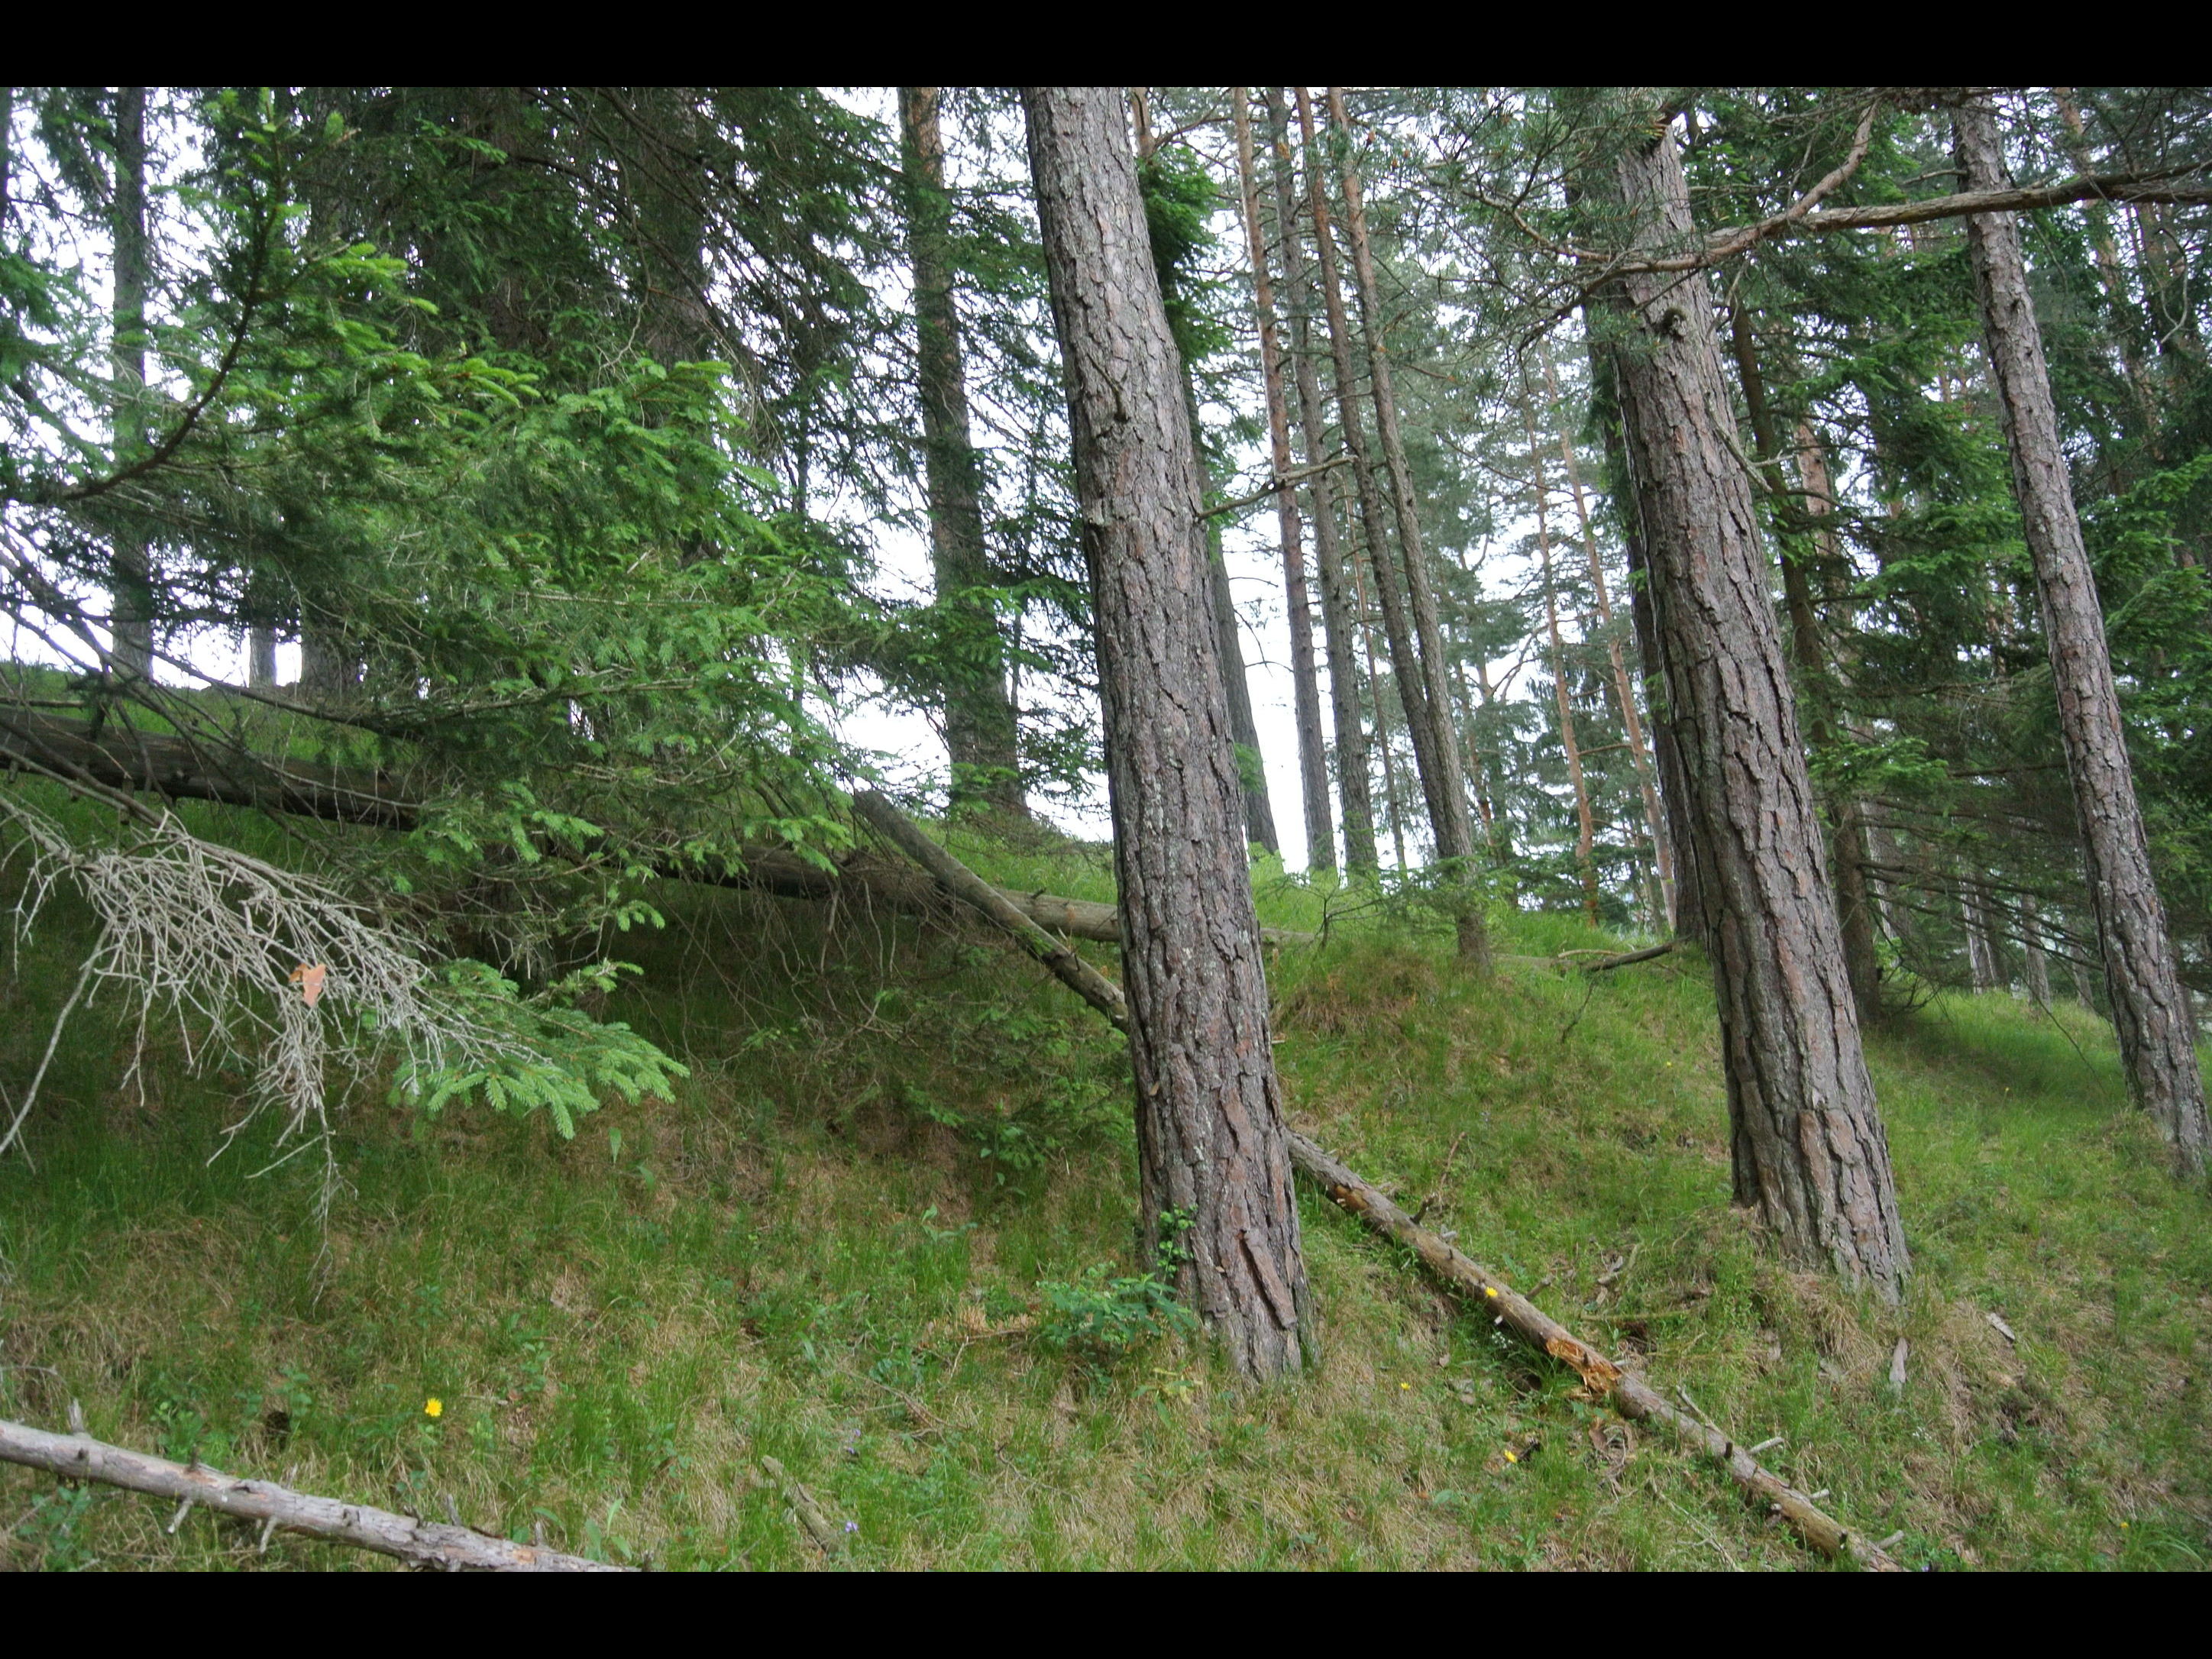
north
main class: Woodland
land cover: Pine dominated coniferous woodland
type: alpine coniferous forest
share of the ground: > 75 %
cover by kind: coniferous forest trees 100 %
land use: Forestry
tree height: > 5 m
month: June
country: AT
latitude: 47.8521
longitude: 15.8429
